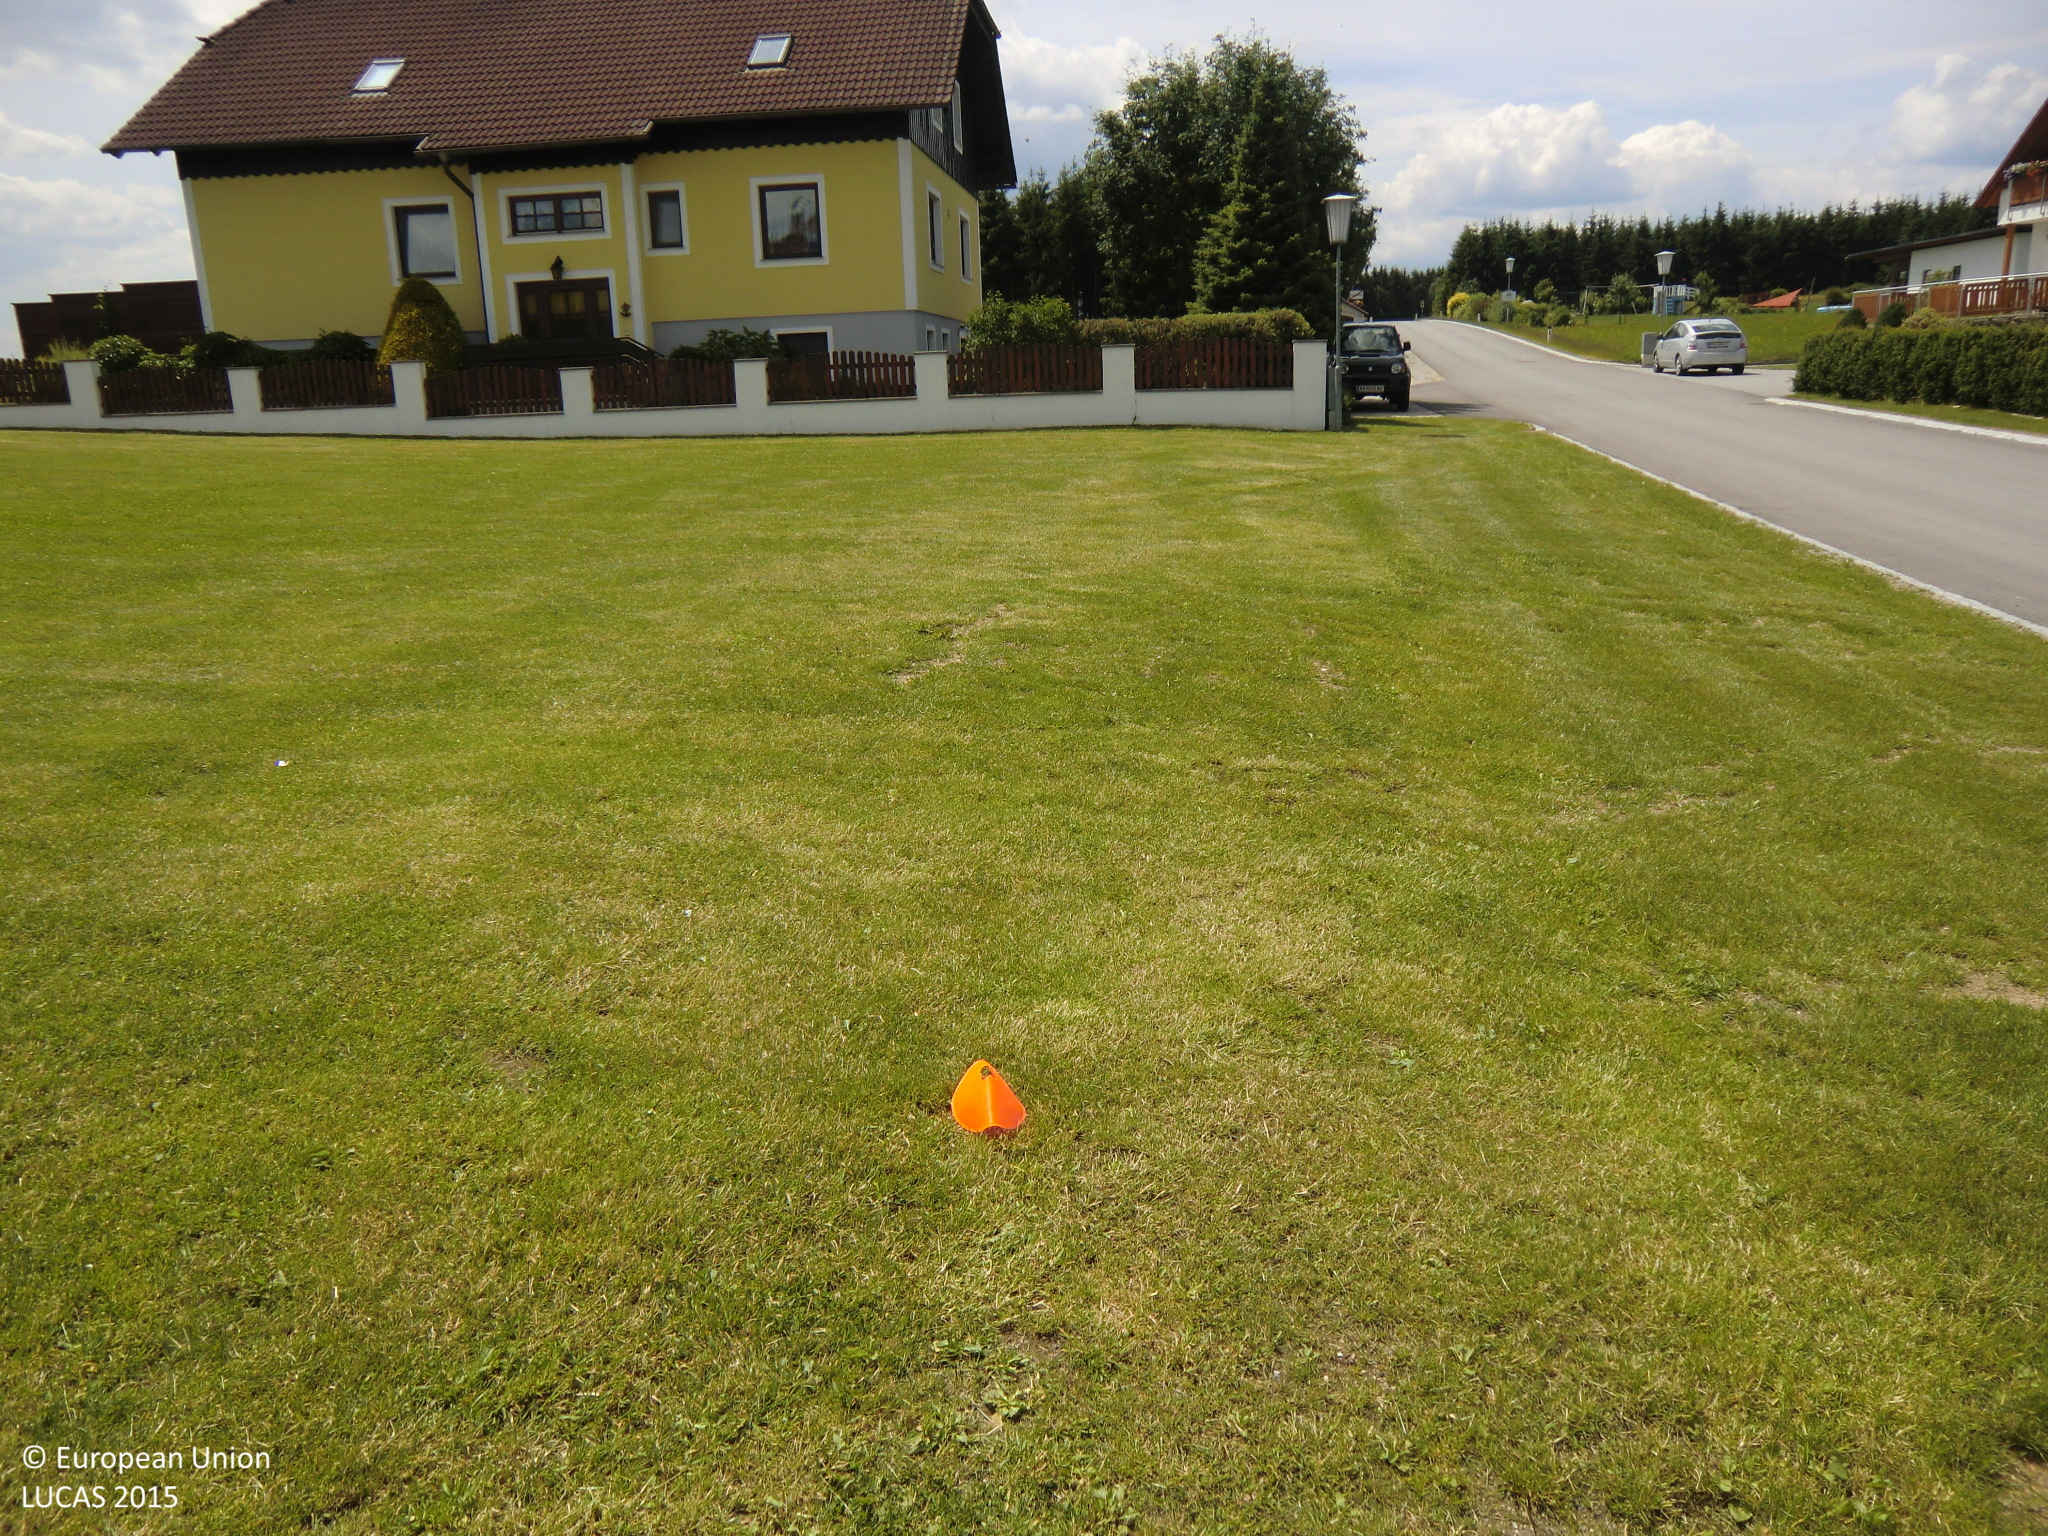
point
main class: Grassland
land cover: Grassland without tree/shrub cover
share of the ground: > 75 %
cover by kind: herbaceous plants 100 %
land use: Residential
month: June
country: AT
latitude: 48.5391
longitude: 15.0809
